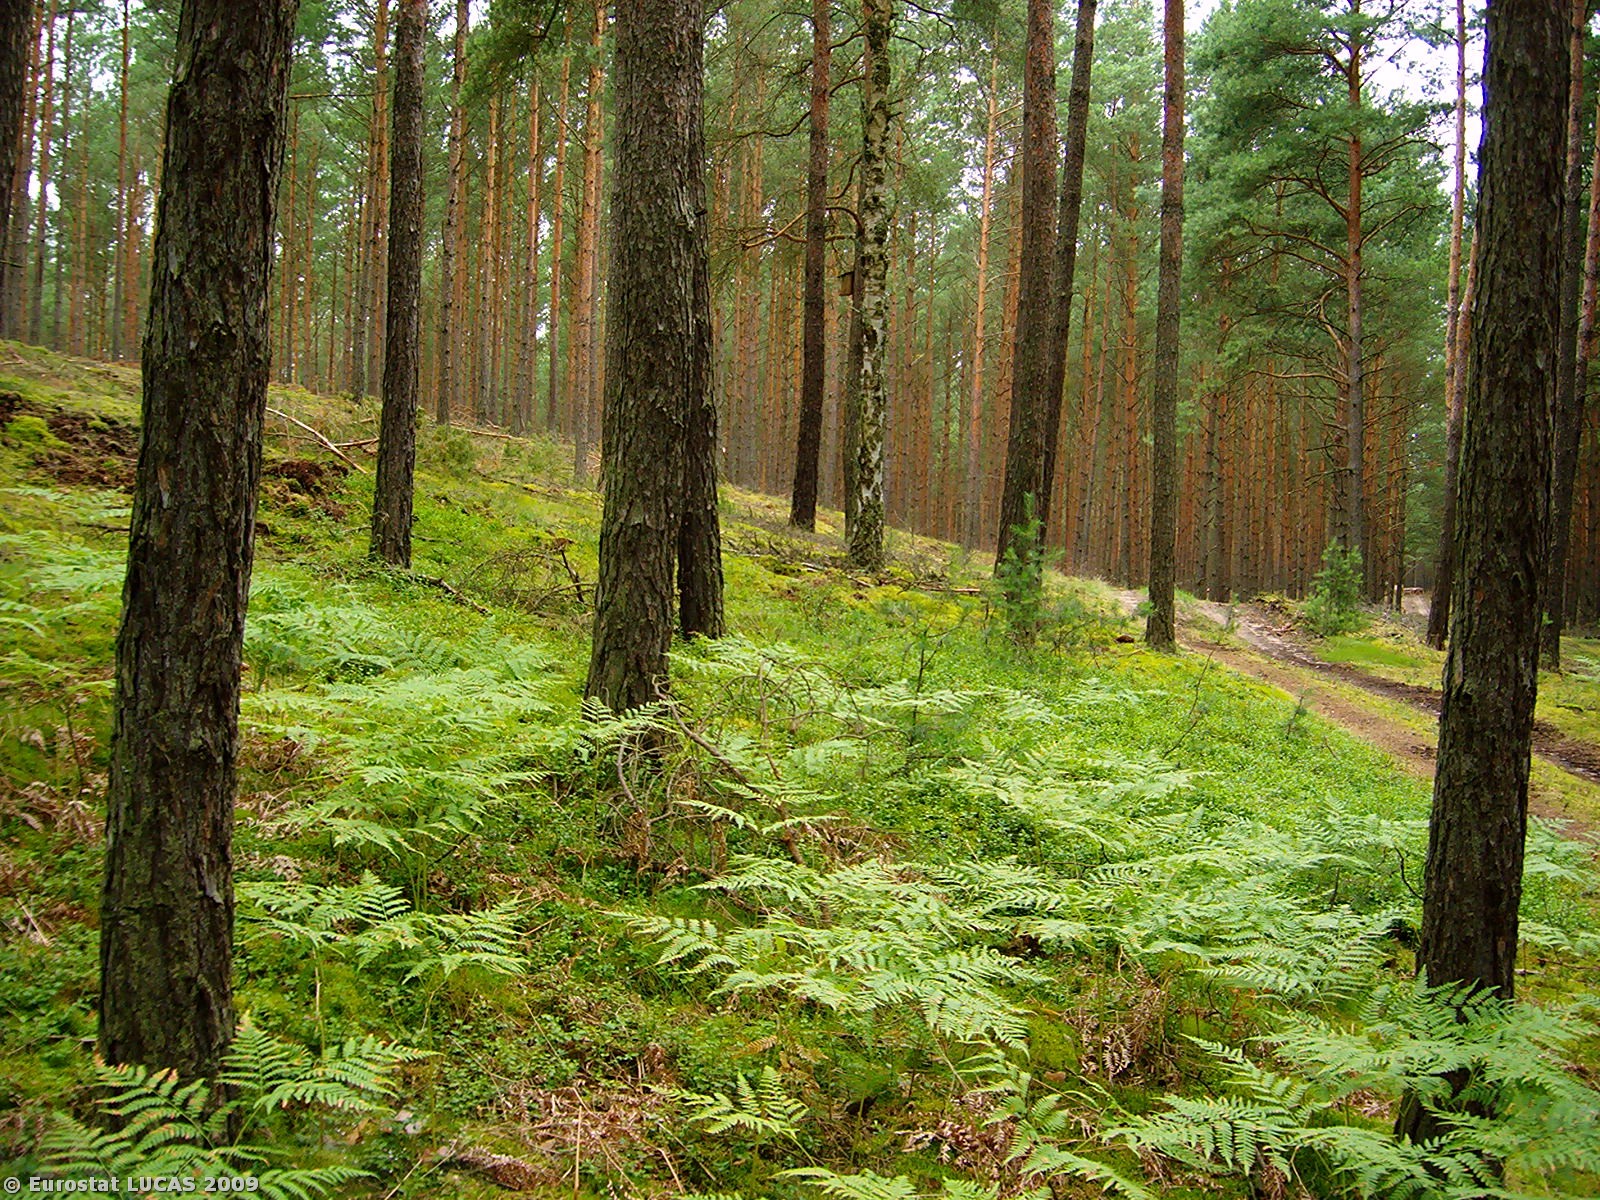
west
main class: Woodland
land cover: Coniferous woodland
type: hemiboreal forest and nemoral coniferous forest and mixed broadleaved-coniferous forest
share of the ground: 50 - 75 %
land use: Forestry
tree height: > 5 m
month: July
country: PL
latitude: 52.5488
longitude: 15.2680
